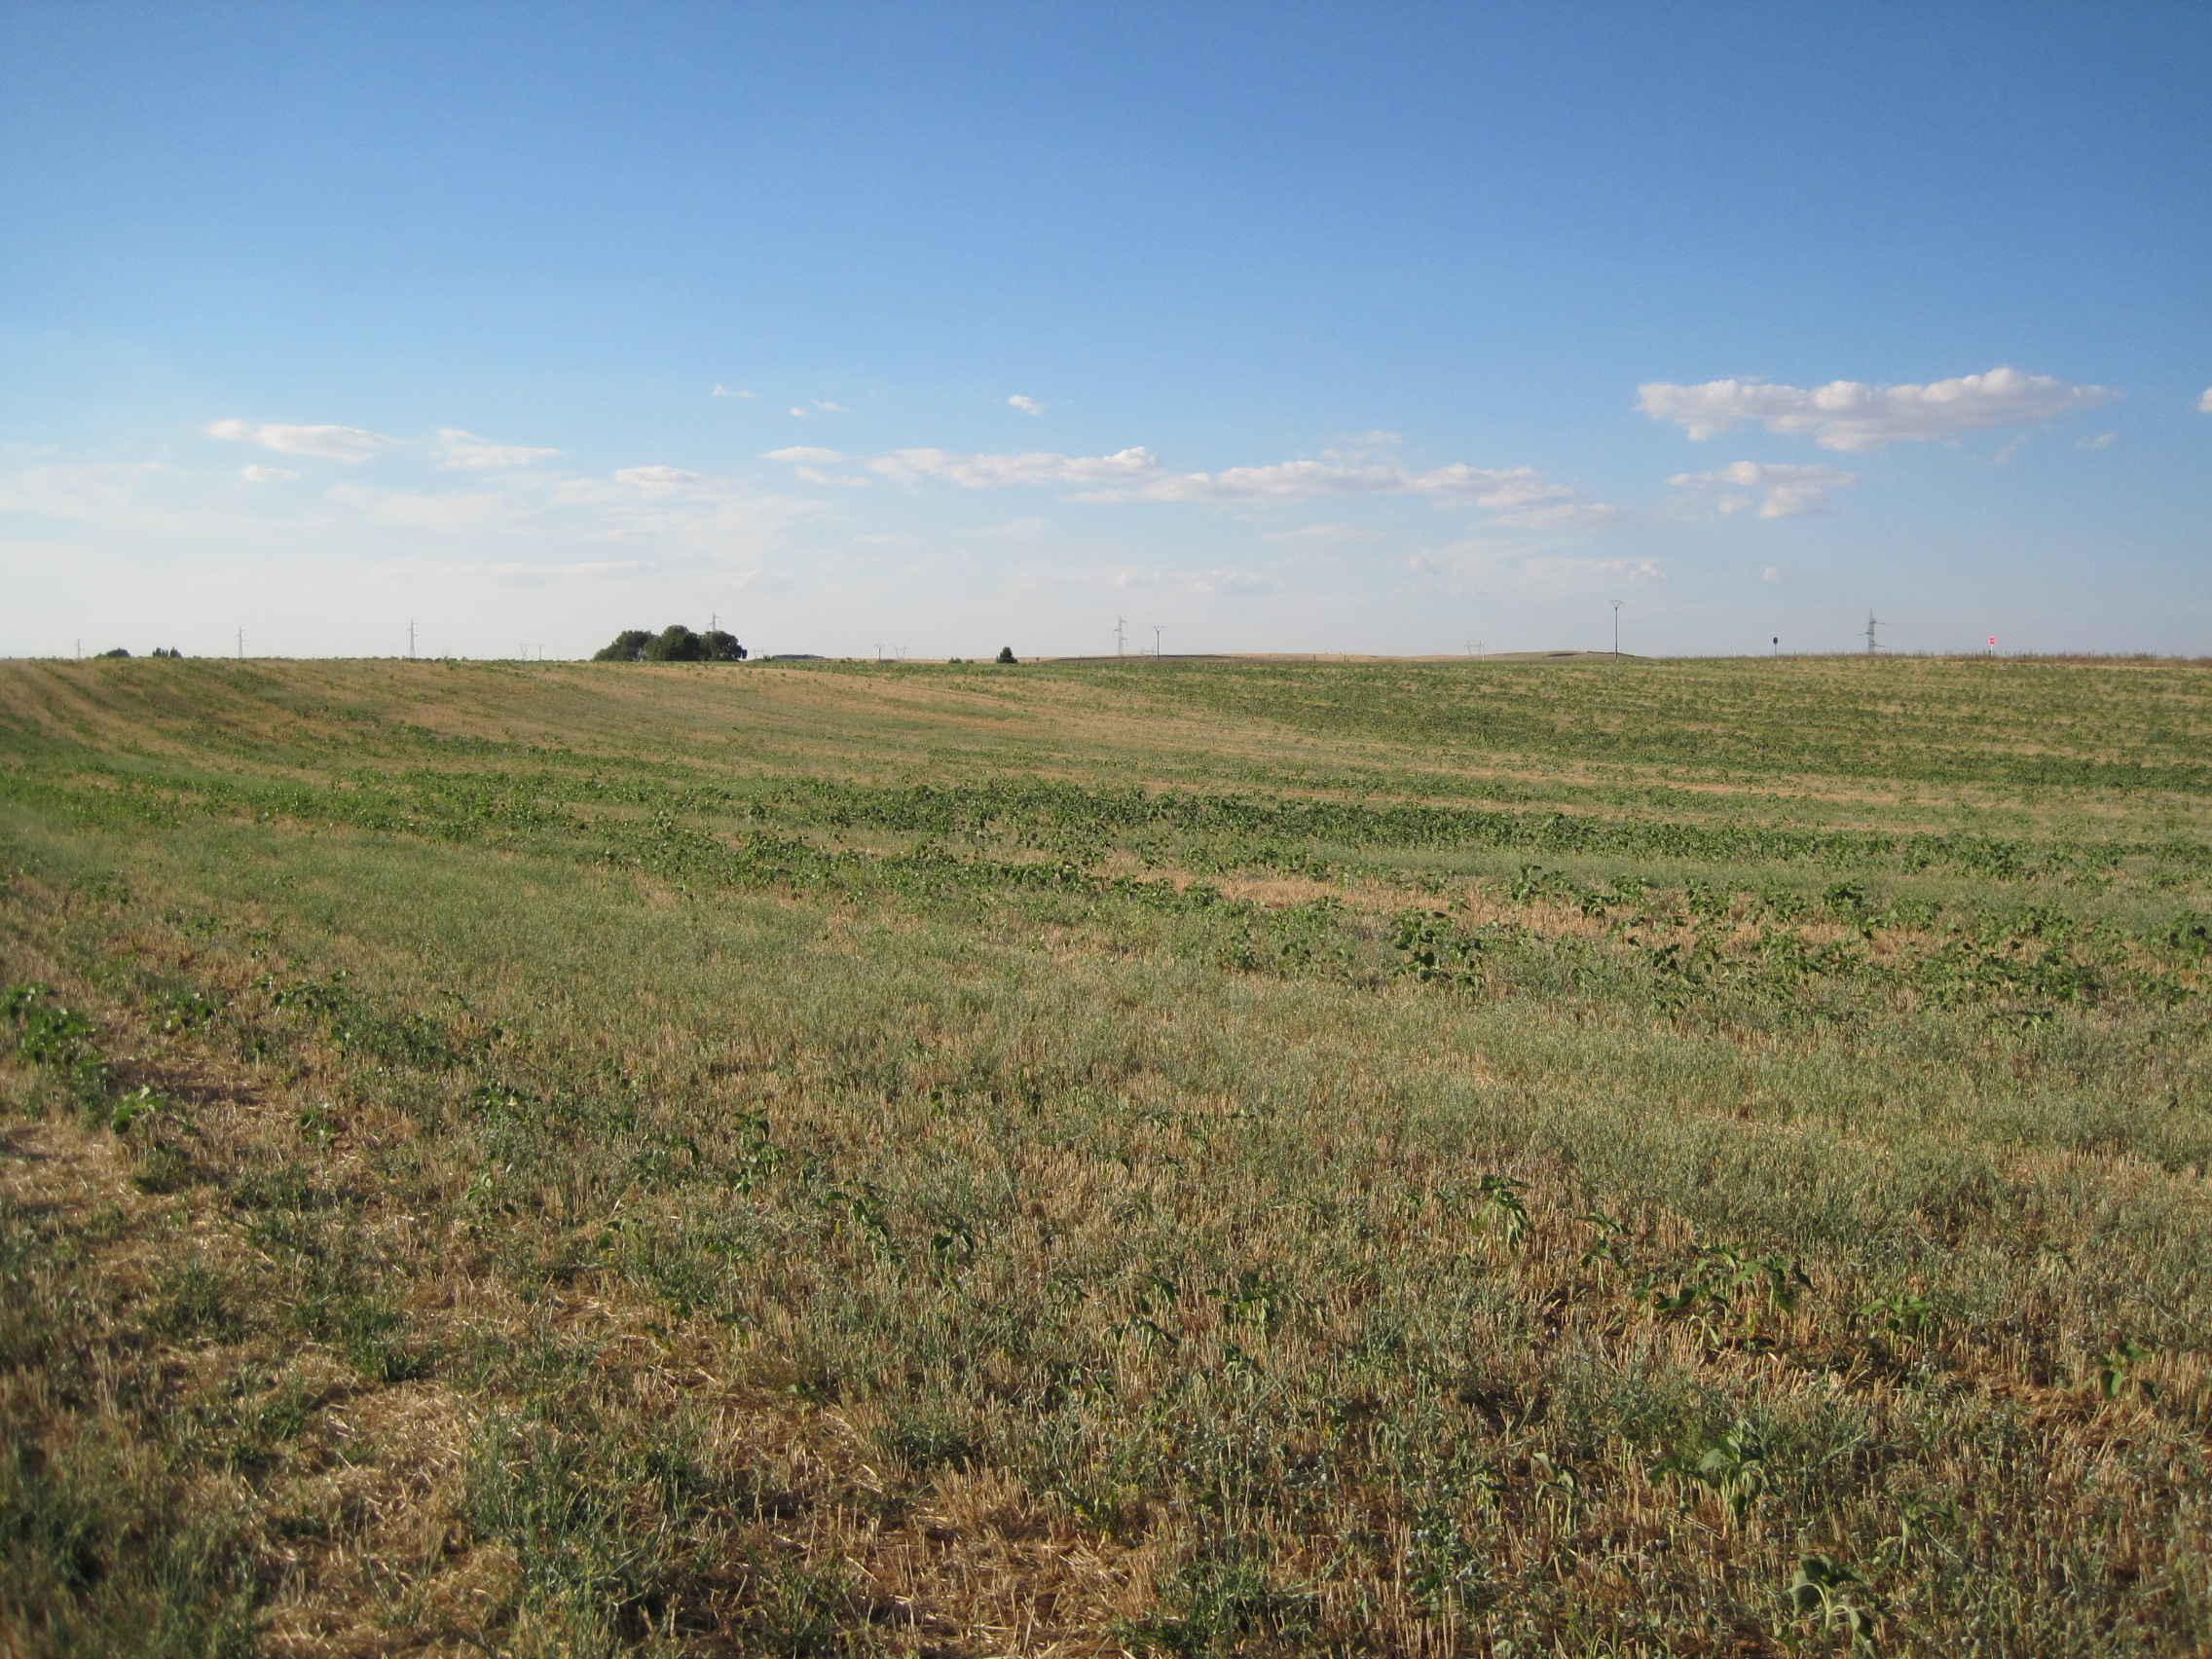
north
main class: Cropland
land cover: Barley
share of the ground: < 10 %
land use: Agriculture (excluding fallow land and kitchen gardens)
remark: Harvested field
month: July
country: ES
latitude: 42.1168
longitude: -5.2394
